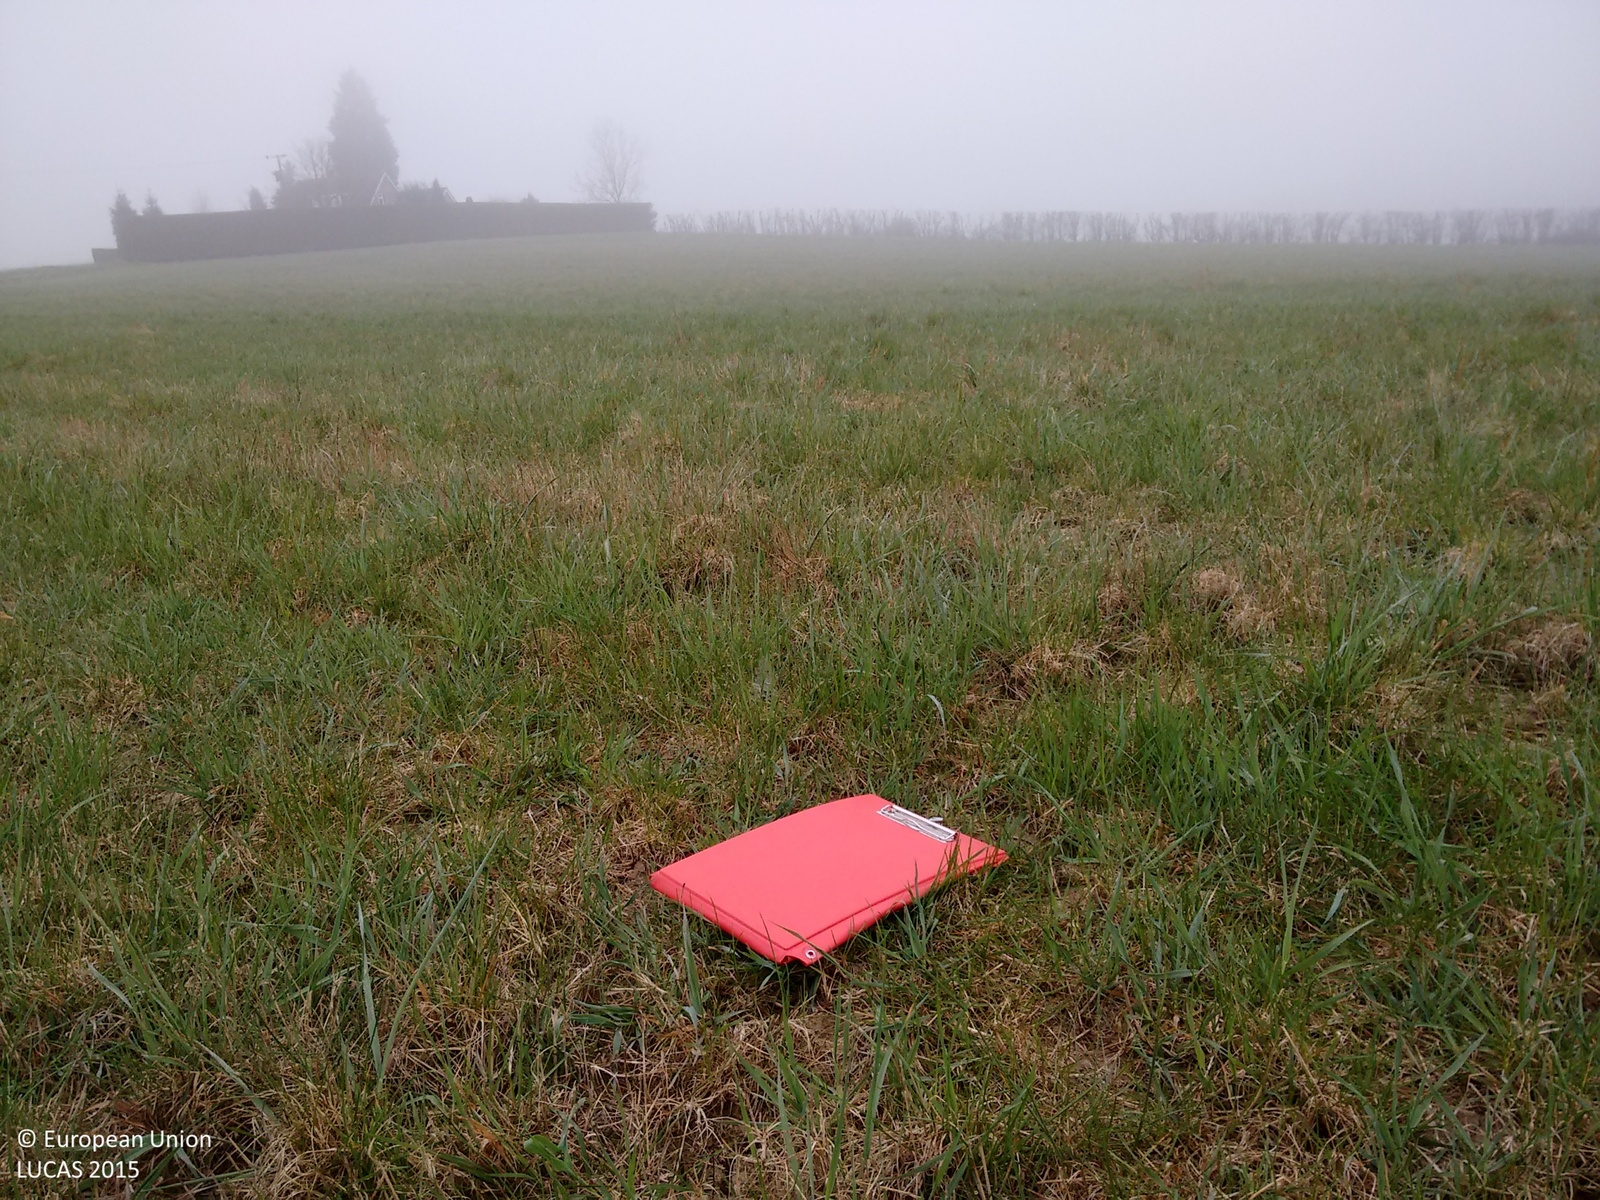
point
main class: Cropland
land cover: Temporary grasslands
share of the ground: > 75 %
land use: Agriculture (excluding fallow land and kitchen gardens)
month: April
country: GB
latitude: 53.9833
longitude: -0.8527
